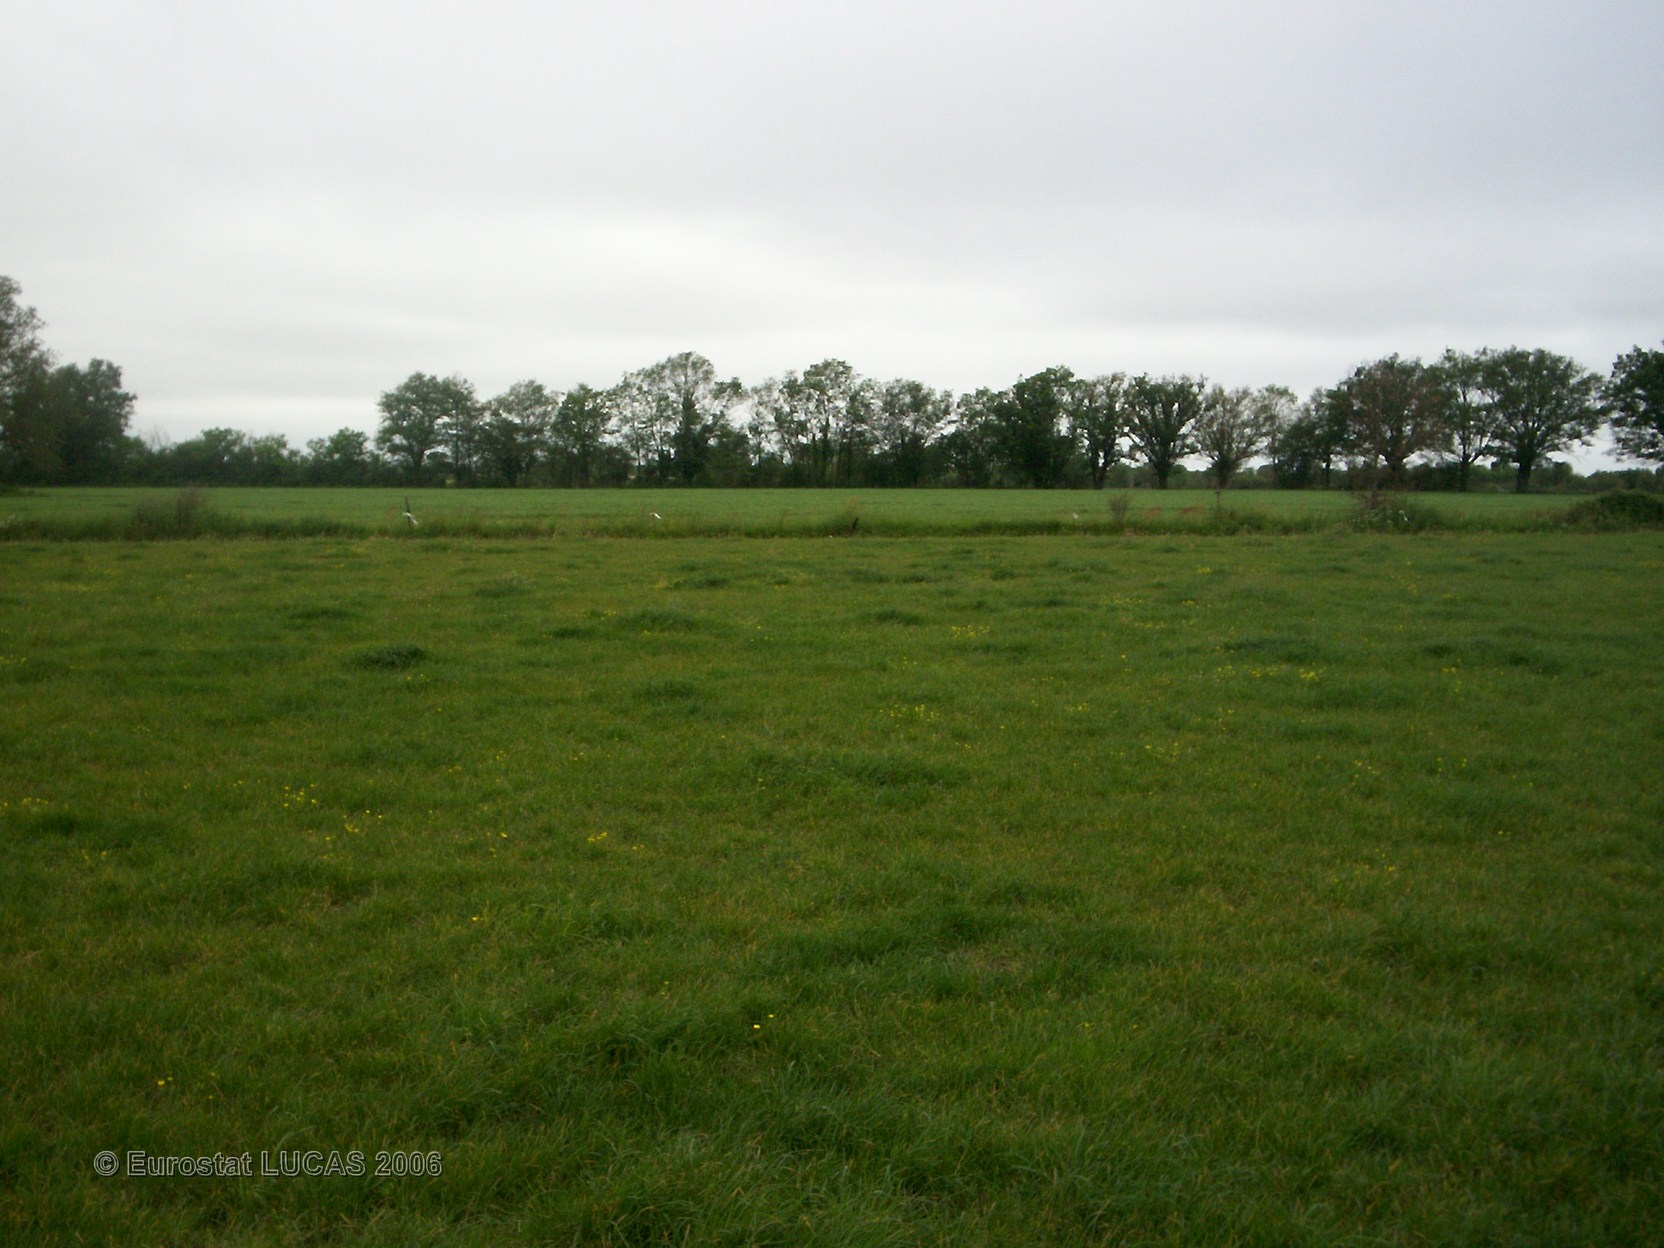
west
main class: Grassland
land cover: Grassland without tree/shrub cover
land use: Agriculture (excluding fallow land and kitchen gardens)
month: May
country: FR
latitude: 47.4326
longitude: -1.3768
